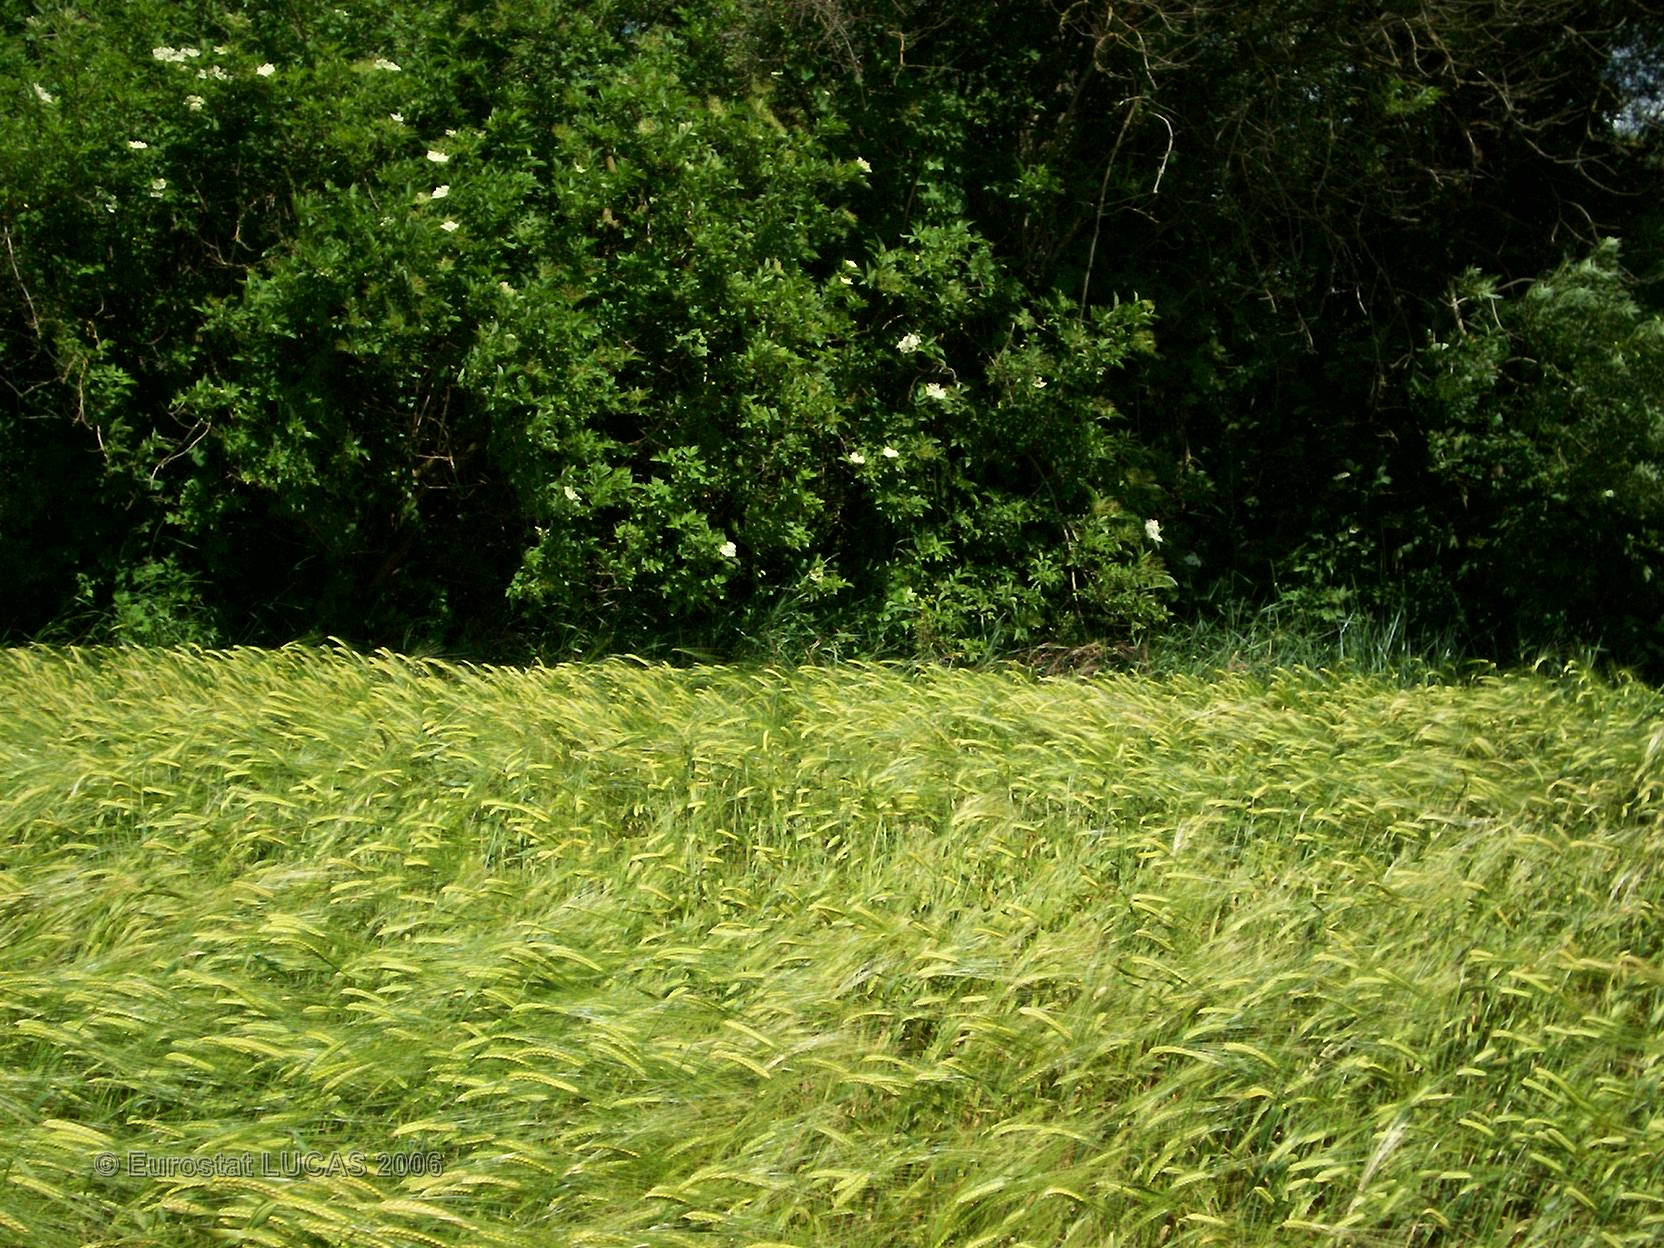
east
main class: Cropland
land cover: Barley
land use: Agriculture (excluding fallow land and kitchen gardens)
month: May
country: FR
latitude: 44.5471
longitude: 4.8335
